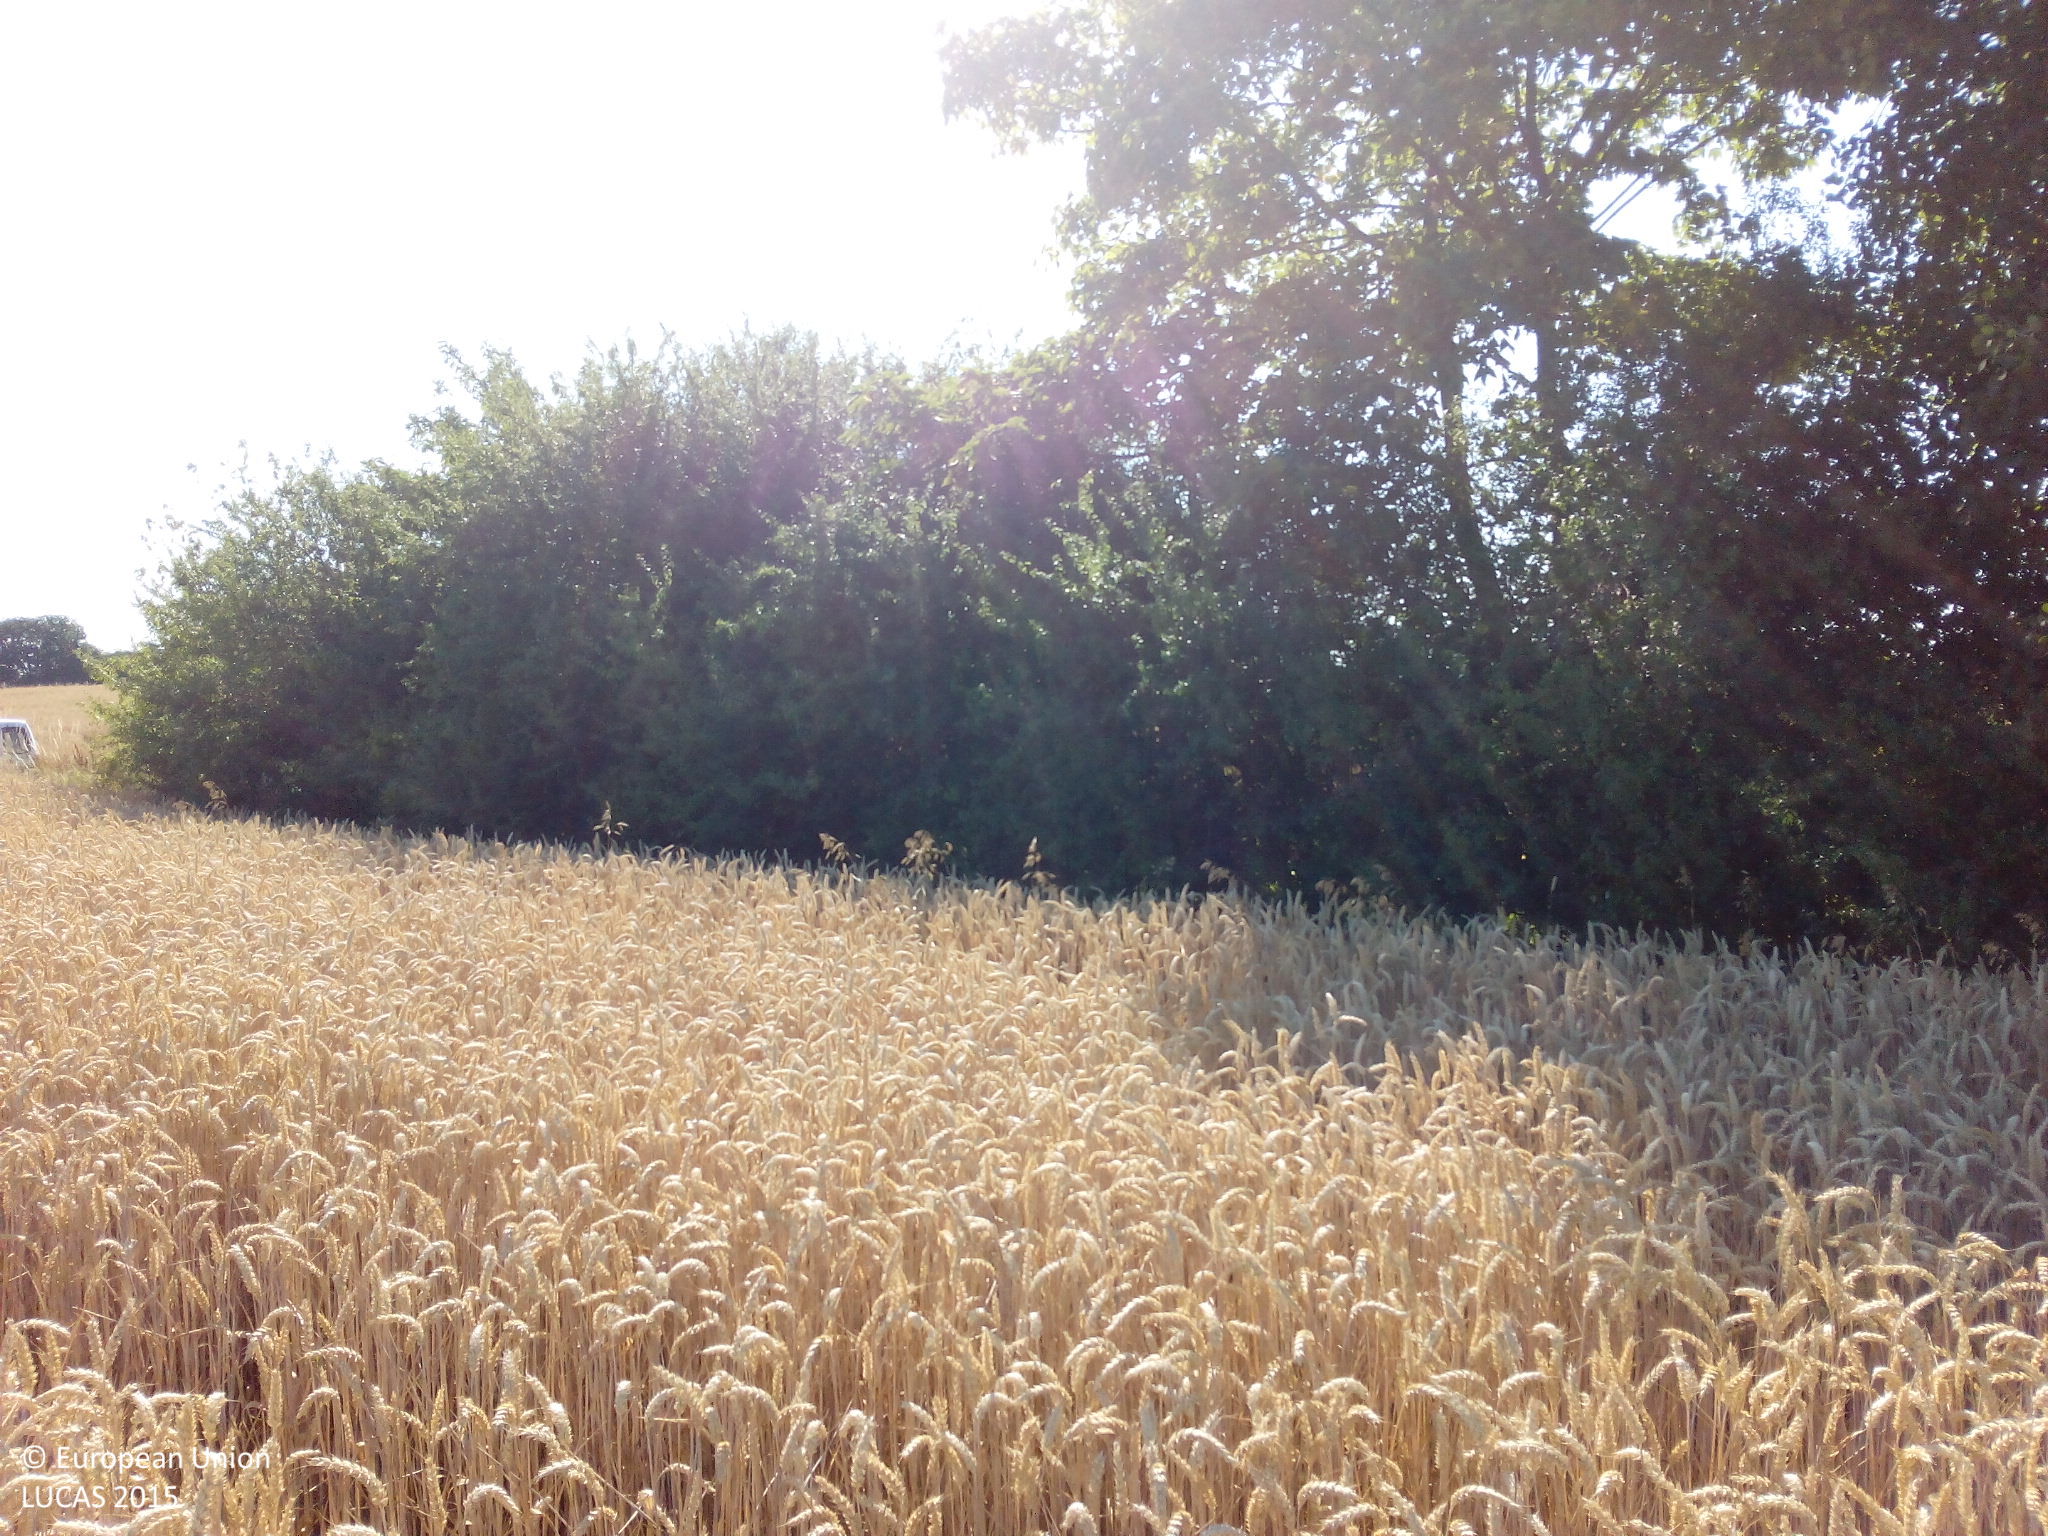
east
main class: Cropland
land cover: Common wheat
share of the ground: > 75 %
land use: Agriculture (excluding fallow land and kitchen gardens)
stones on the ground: < 10 %
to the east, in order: Common wheat; Shrubland with sparse tree cover; Grass margins; Paved roads, cycling and walking lanes; Ditches and canals; Grass margins; Common wheat; Ditches and canals; Grass margins; Paved roads, cycling and walking lanes; Grass margins; Barley
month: July
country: DE
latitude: 49.2761
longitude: 7.5401
